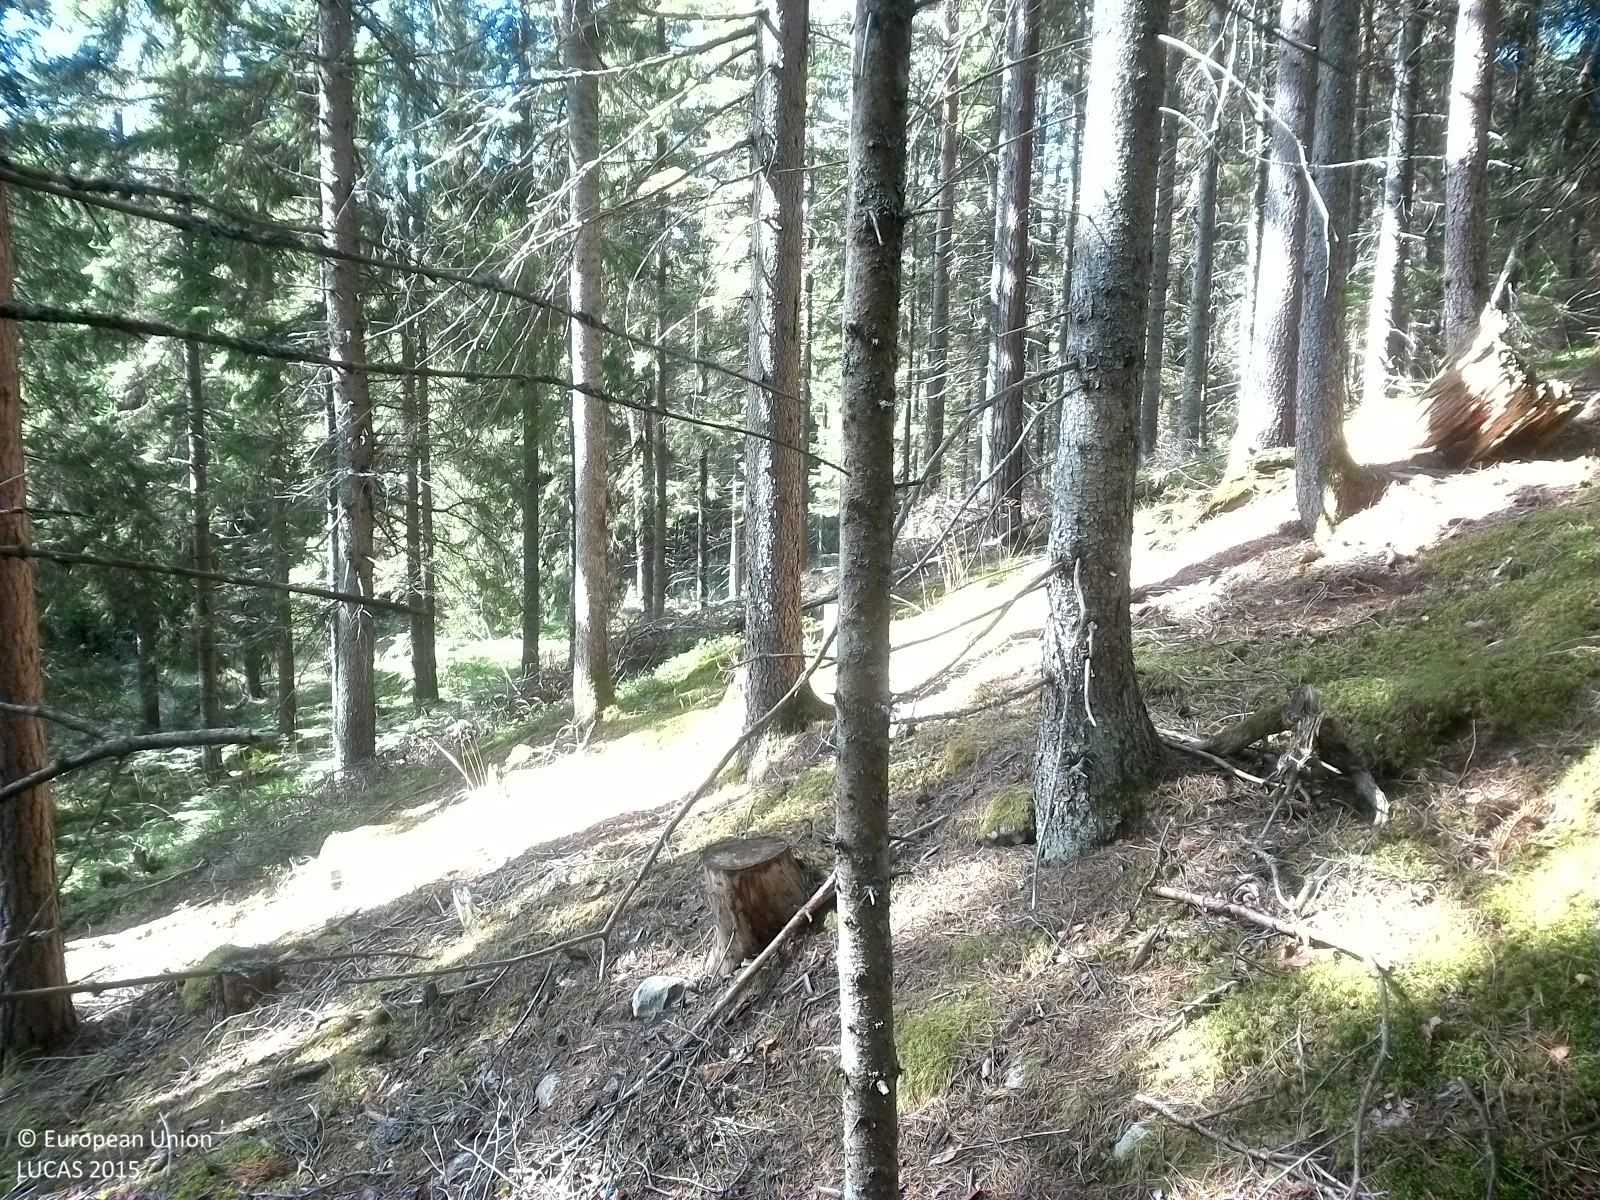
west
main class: Woodland
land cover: Other coniferous woodland
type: boreal forest
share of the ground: 25 - 50 %
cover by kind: coniferous forest trees 40 %, lichens and mosses 30 %, unconsolidated bare surface 20 %, broadleaved forest trees 5 %, herbaceous plants 5 %
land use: Forestry
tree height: > 5 m
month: August
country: SE
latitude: 58.6298
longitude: 15.0397
